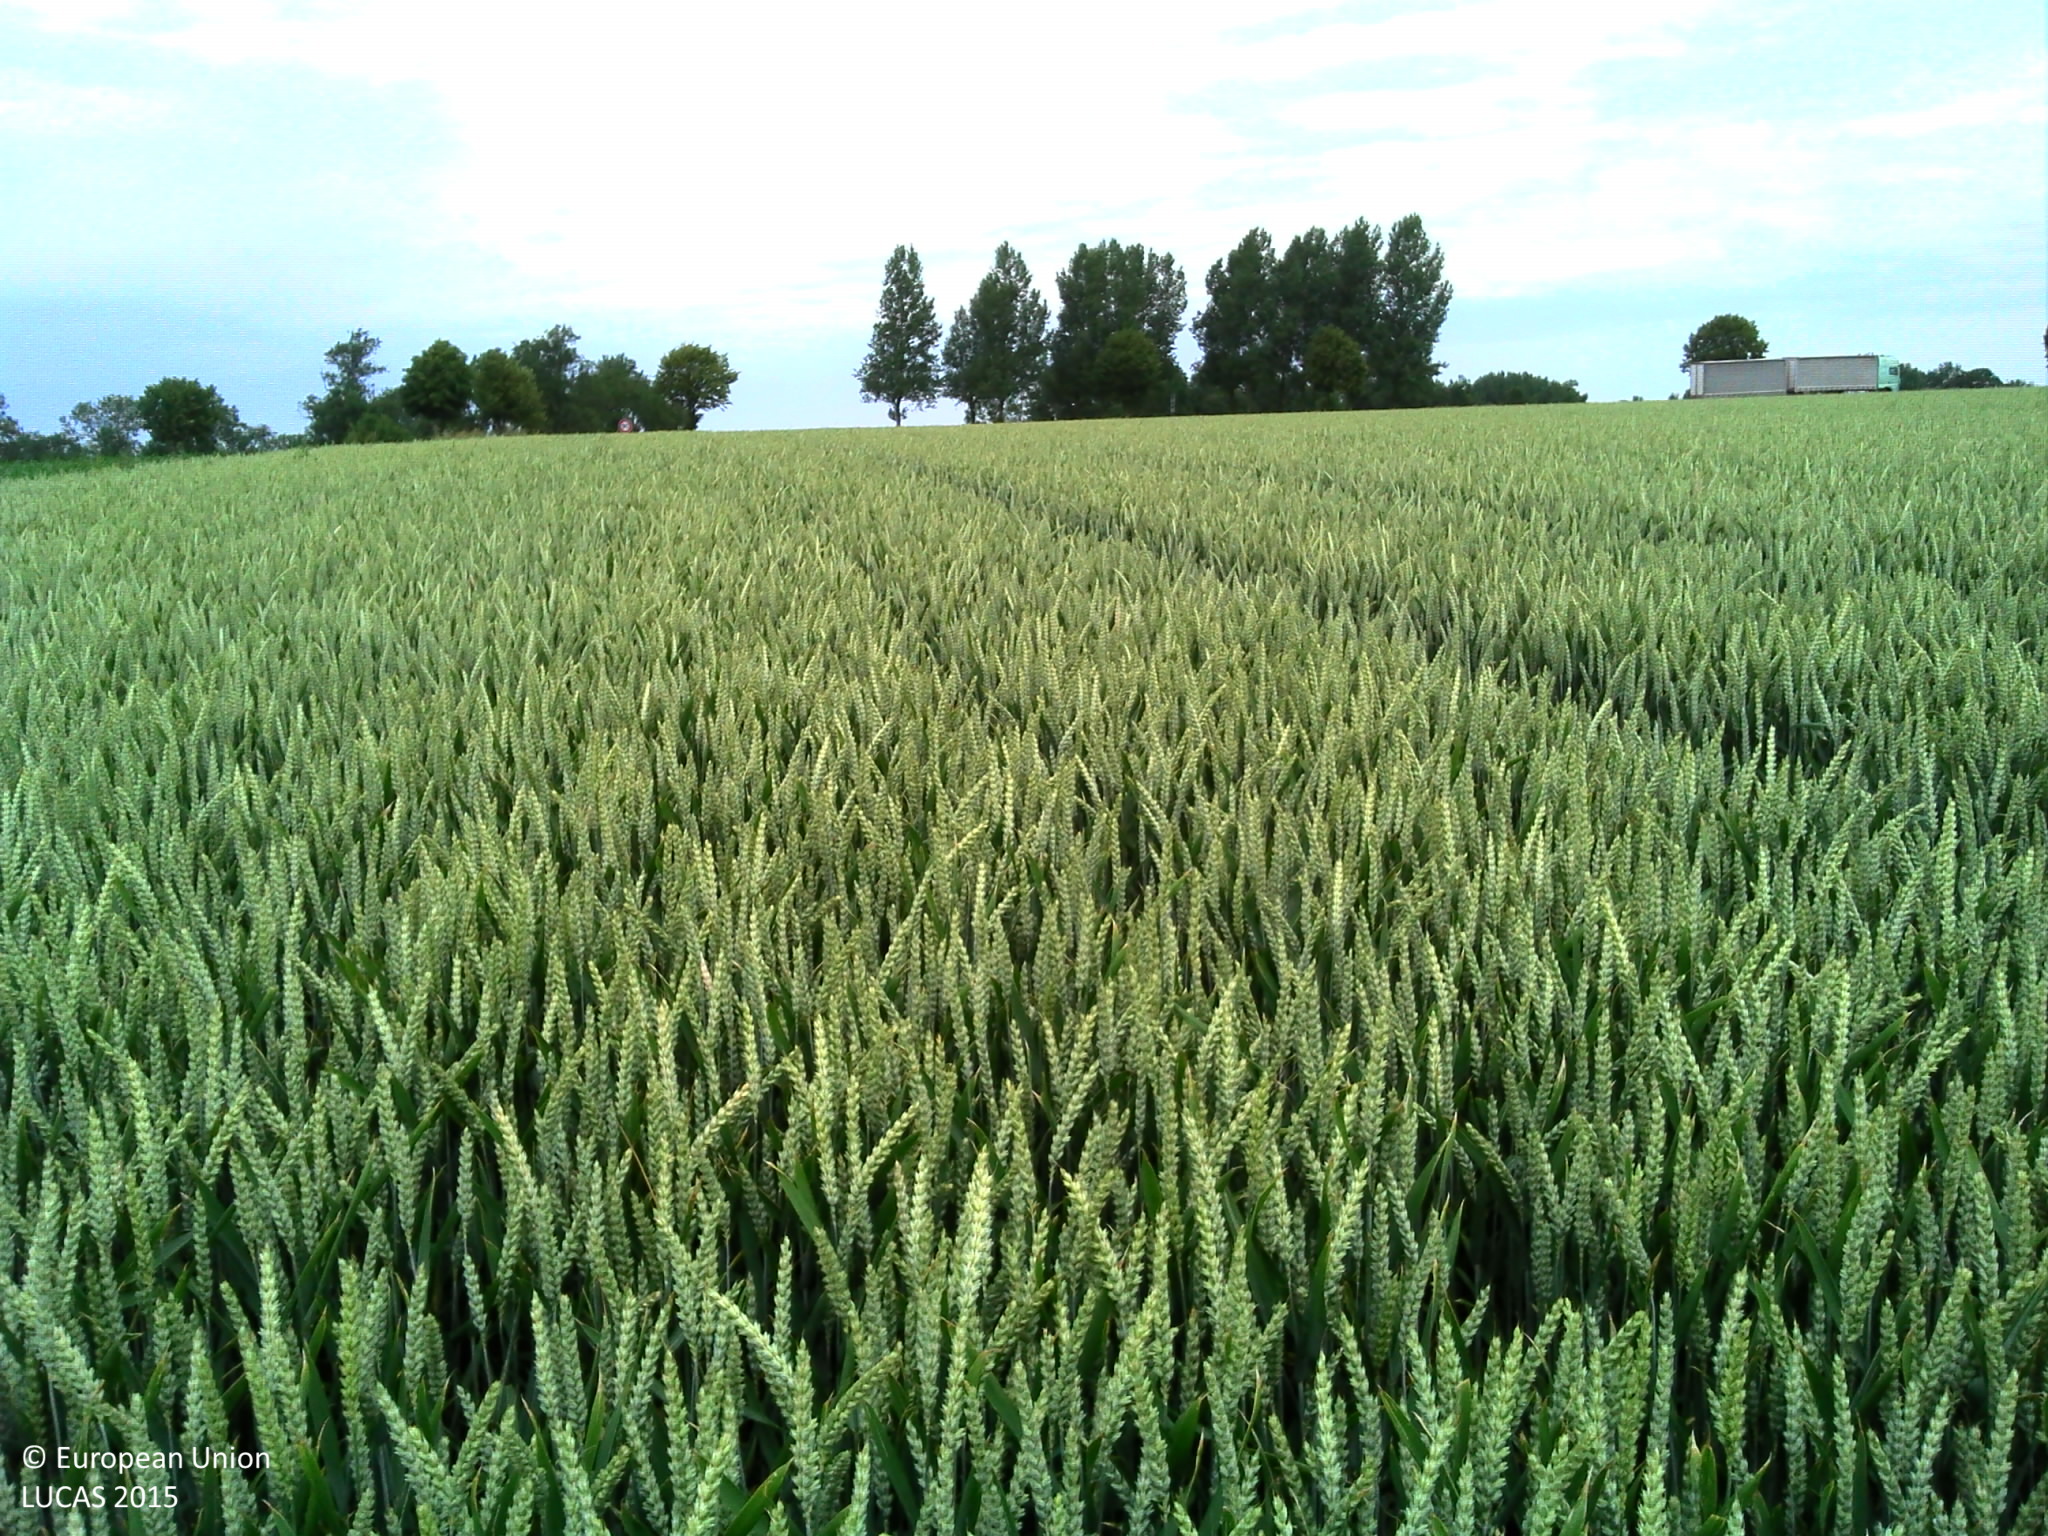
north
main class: Cropland
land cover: Common wheat
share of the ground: > 75 %
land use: Agriculture (excluding fallow land and kitchen gardens)
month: July
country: FR
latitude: 50.3832
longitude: 2.1519
